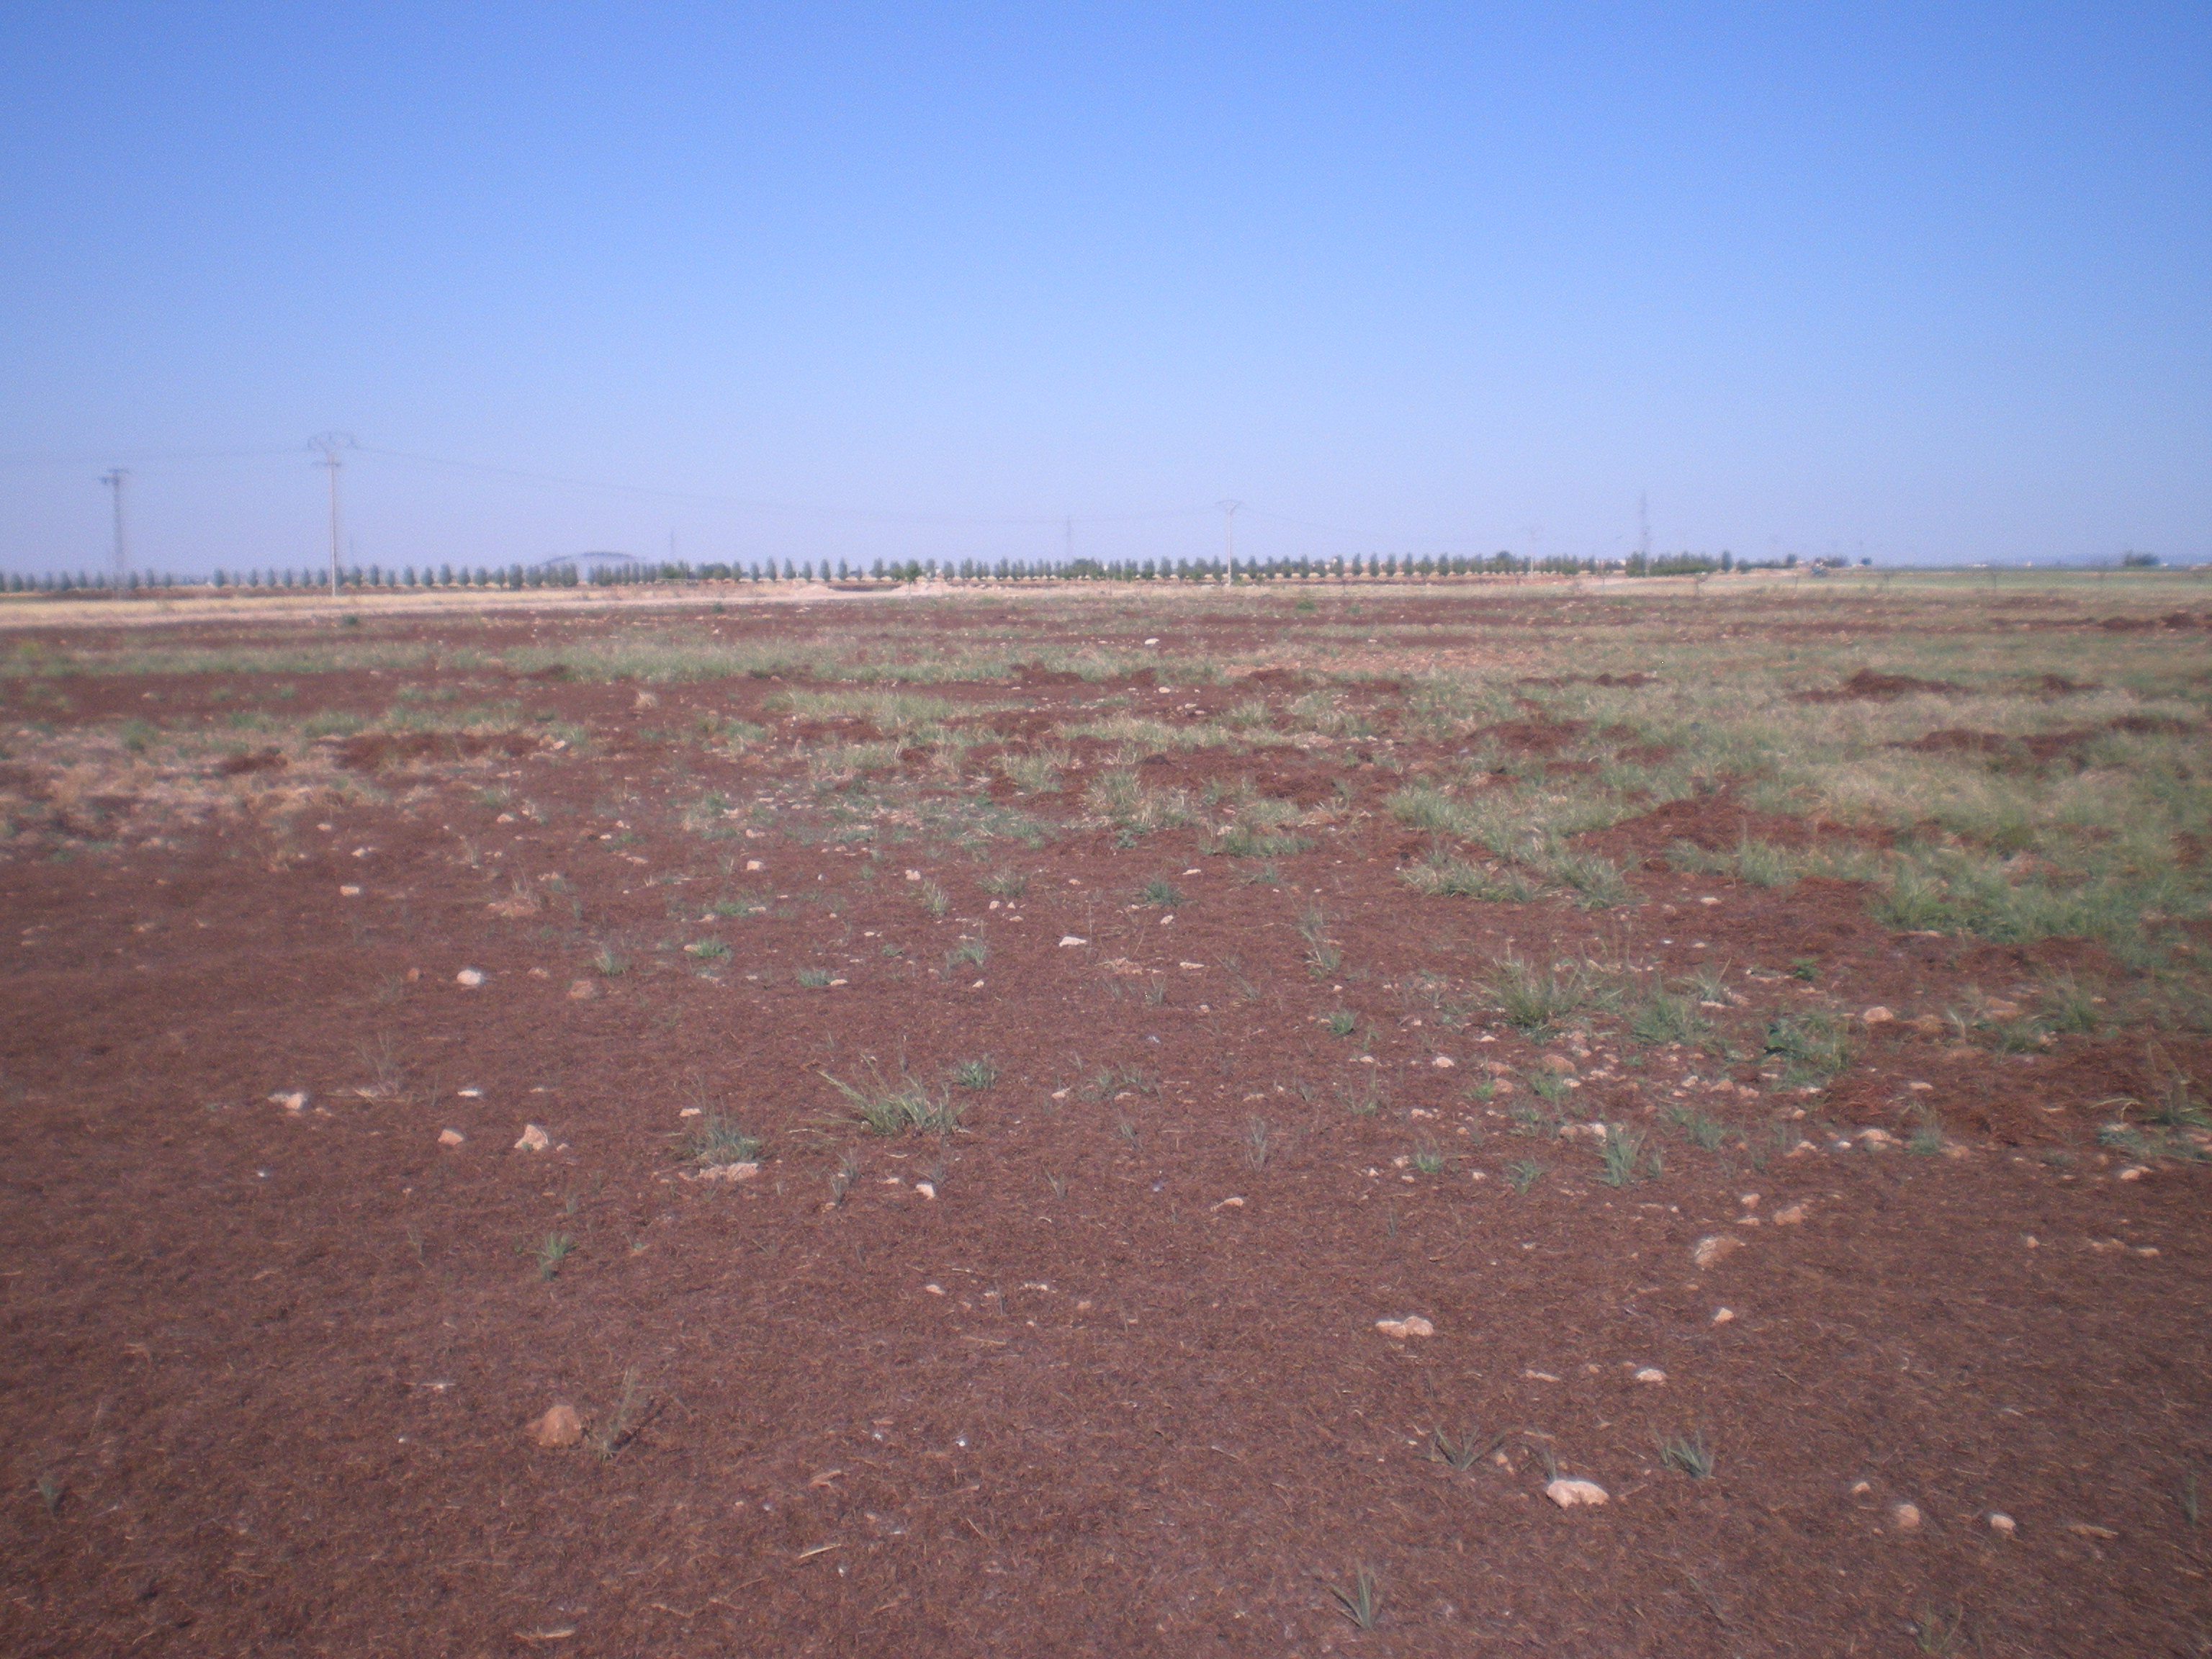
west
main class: Grassland
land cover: Spontaneously vegetated surfaces
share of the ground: 10 - 25 %
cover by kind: unconsolidated bare surface 85 %, herbaceous plants 15 %
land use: Agriculture (excluding fallow land and kitchen gardens)
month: May
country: ES
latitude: 39.0238
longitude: -3.5889
